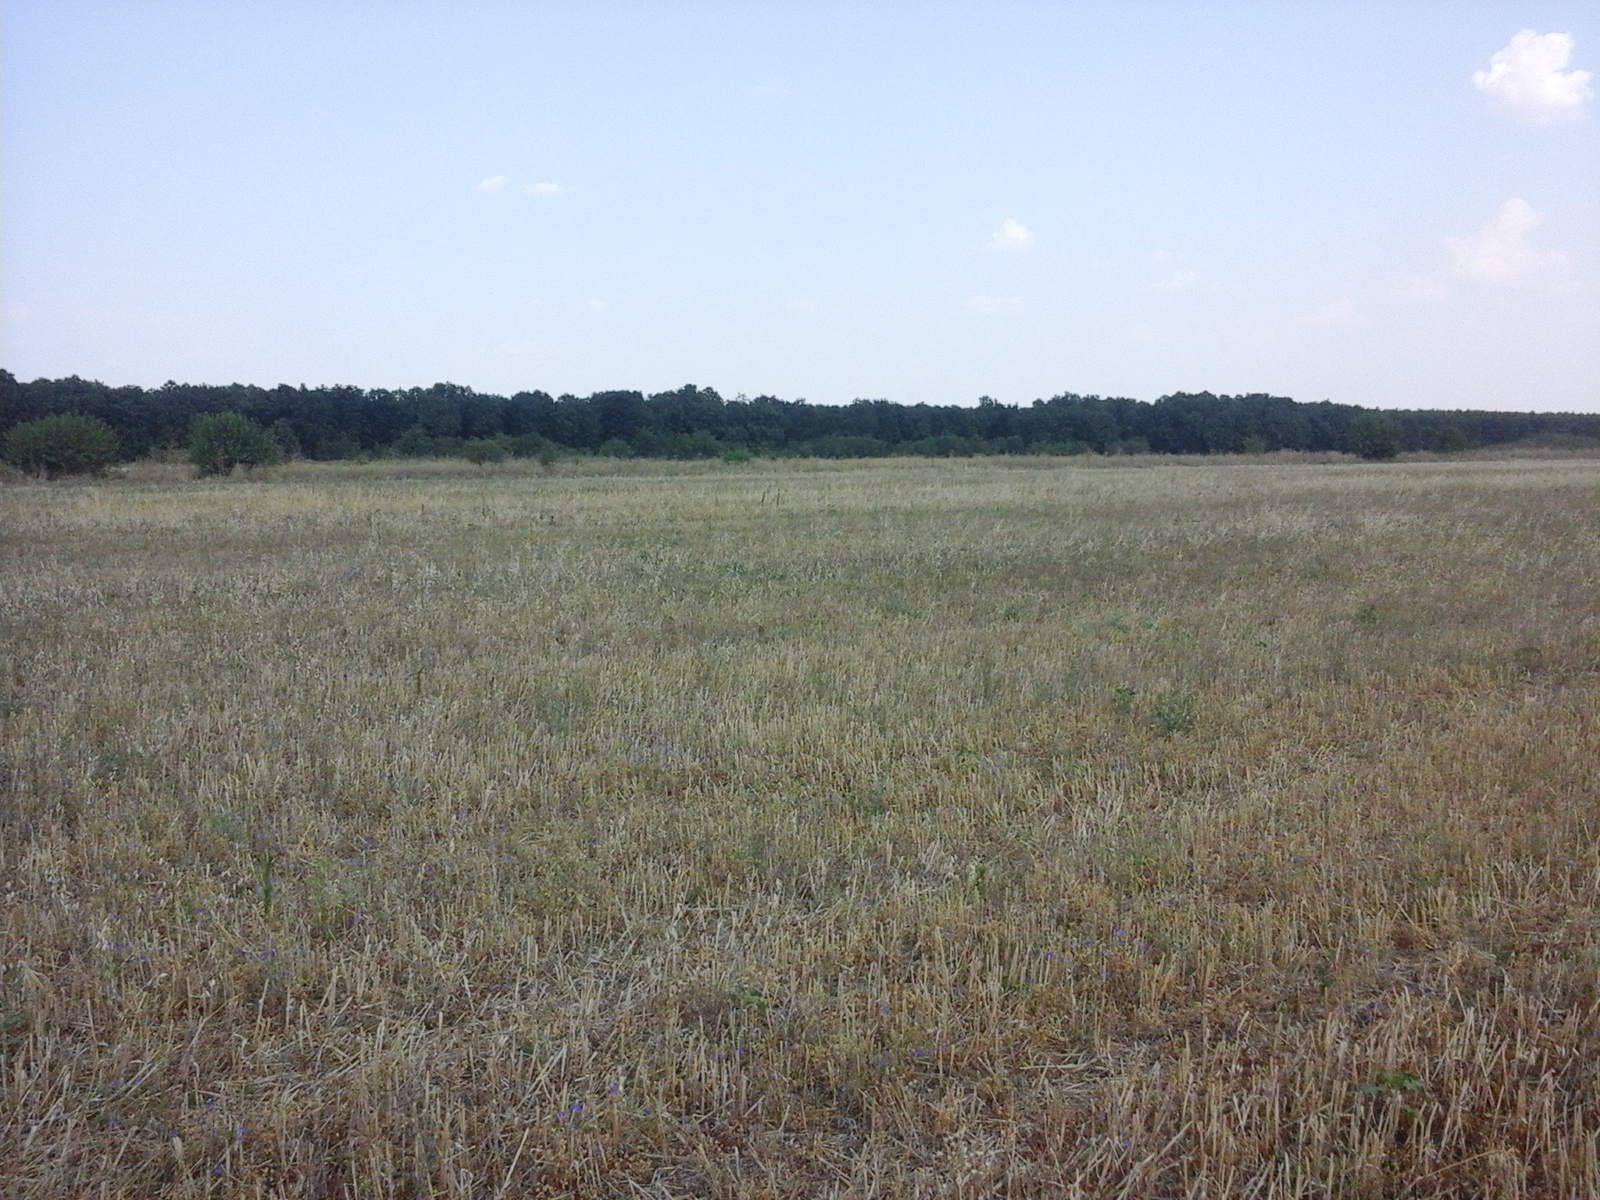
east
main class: Cropland
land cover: Oats
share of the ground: > 75 %
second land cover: Spontaneously vegetated surfaces
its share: 10 - 25 %
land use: Agriculture (excluding fallow land and kitchen gardens)
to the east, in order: Oats; Spontaneously vegetated surfaces; Paved roads, cycling and walking lanes; Spontaneously vegetated surfaces; Common wheat
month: August
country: RO
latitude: 44.1668
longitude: 23.5706
